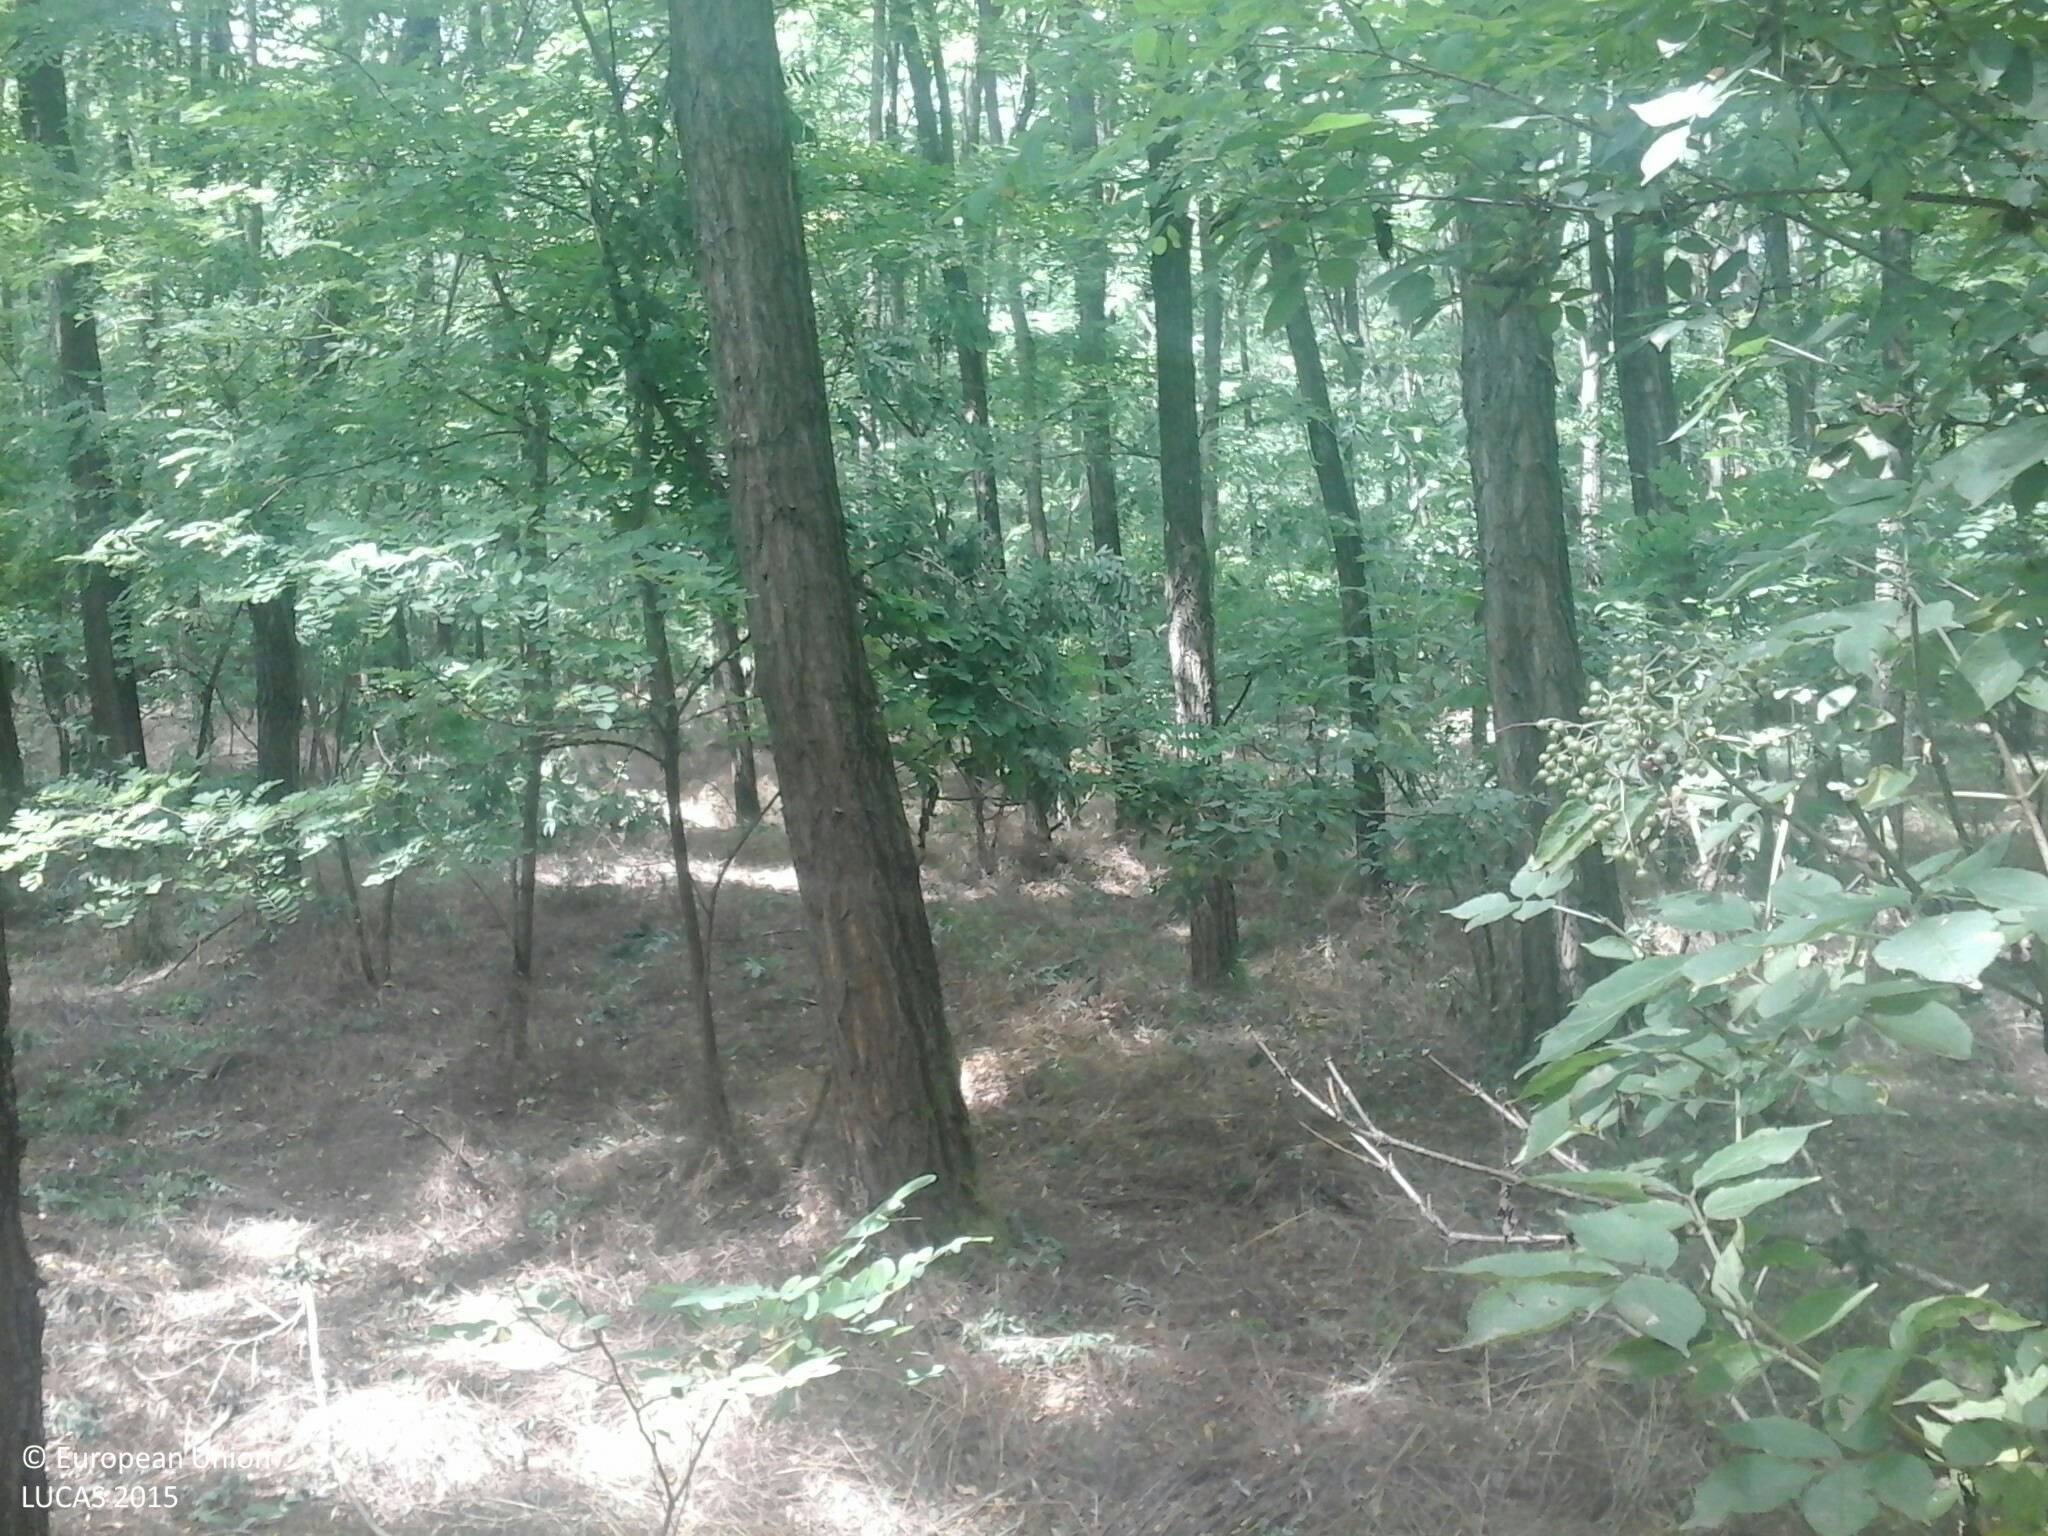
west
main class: Woodland
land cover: Broadleaved woodland
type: mesophytic deciduous forest
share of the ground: > 75 %
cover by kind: broadleaved forest trees 95 %, herbaceous plants 5 %
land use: Forestry
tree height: > 5 m
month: July
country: HU
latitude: 47.2114
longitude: 19.3272
